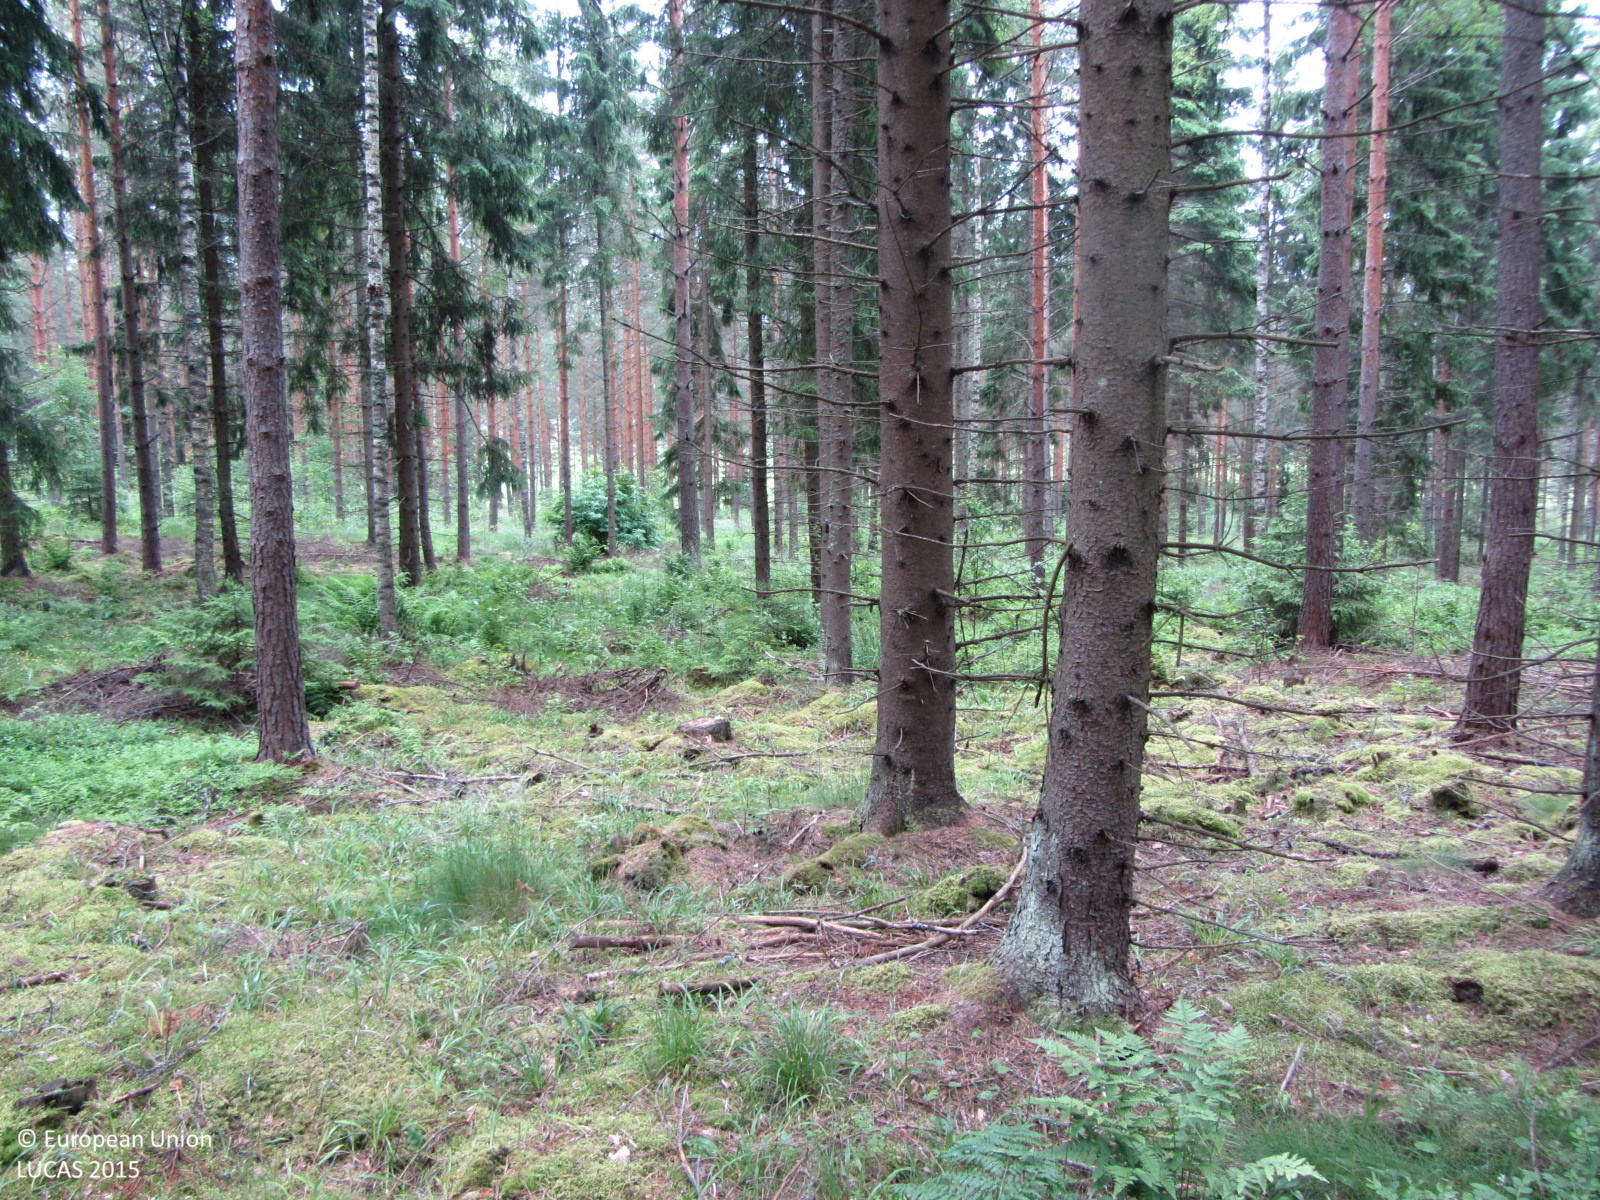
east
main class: Woodland
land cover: Spruce dominated coniferous woodland
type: boreal forest
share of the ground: > 75 %
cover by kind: coniferous forest trees 70 %, herbaceous plants 15 %, broadleaved forest trees 5 %, shrubs 5 %, lichens and mosses 5 %
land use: Forestry
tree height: > 5 m
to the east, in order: Spruce dominated coniferous woodland; Other mixed woodland; Tracks; Pine dominated coniferous woodland; Ditches and canals; Spontaneously vegetated surfaces; Ditches and canals; Grassland without tree/shrub cover; Sugar beet
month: June
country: FI
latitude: 60.1972
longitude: 23.1967
